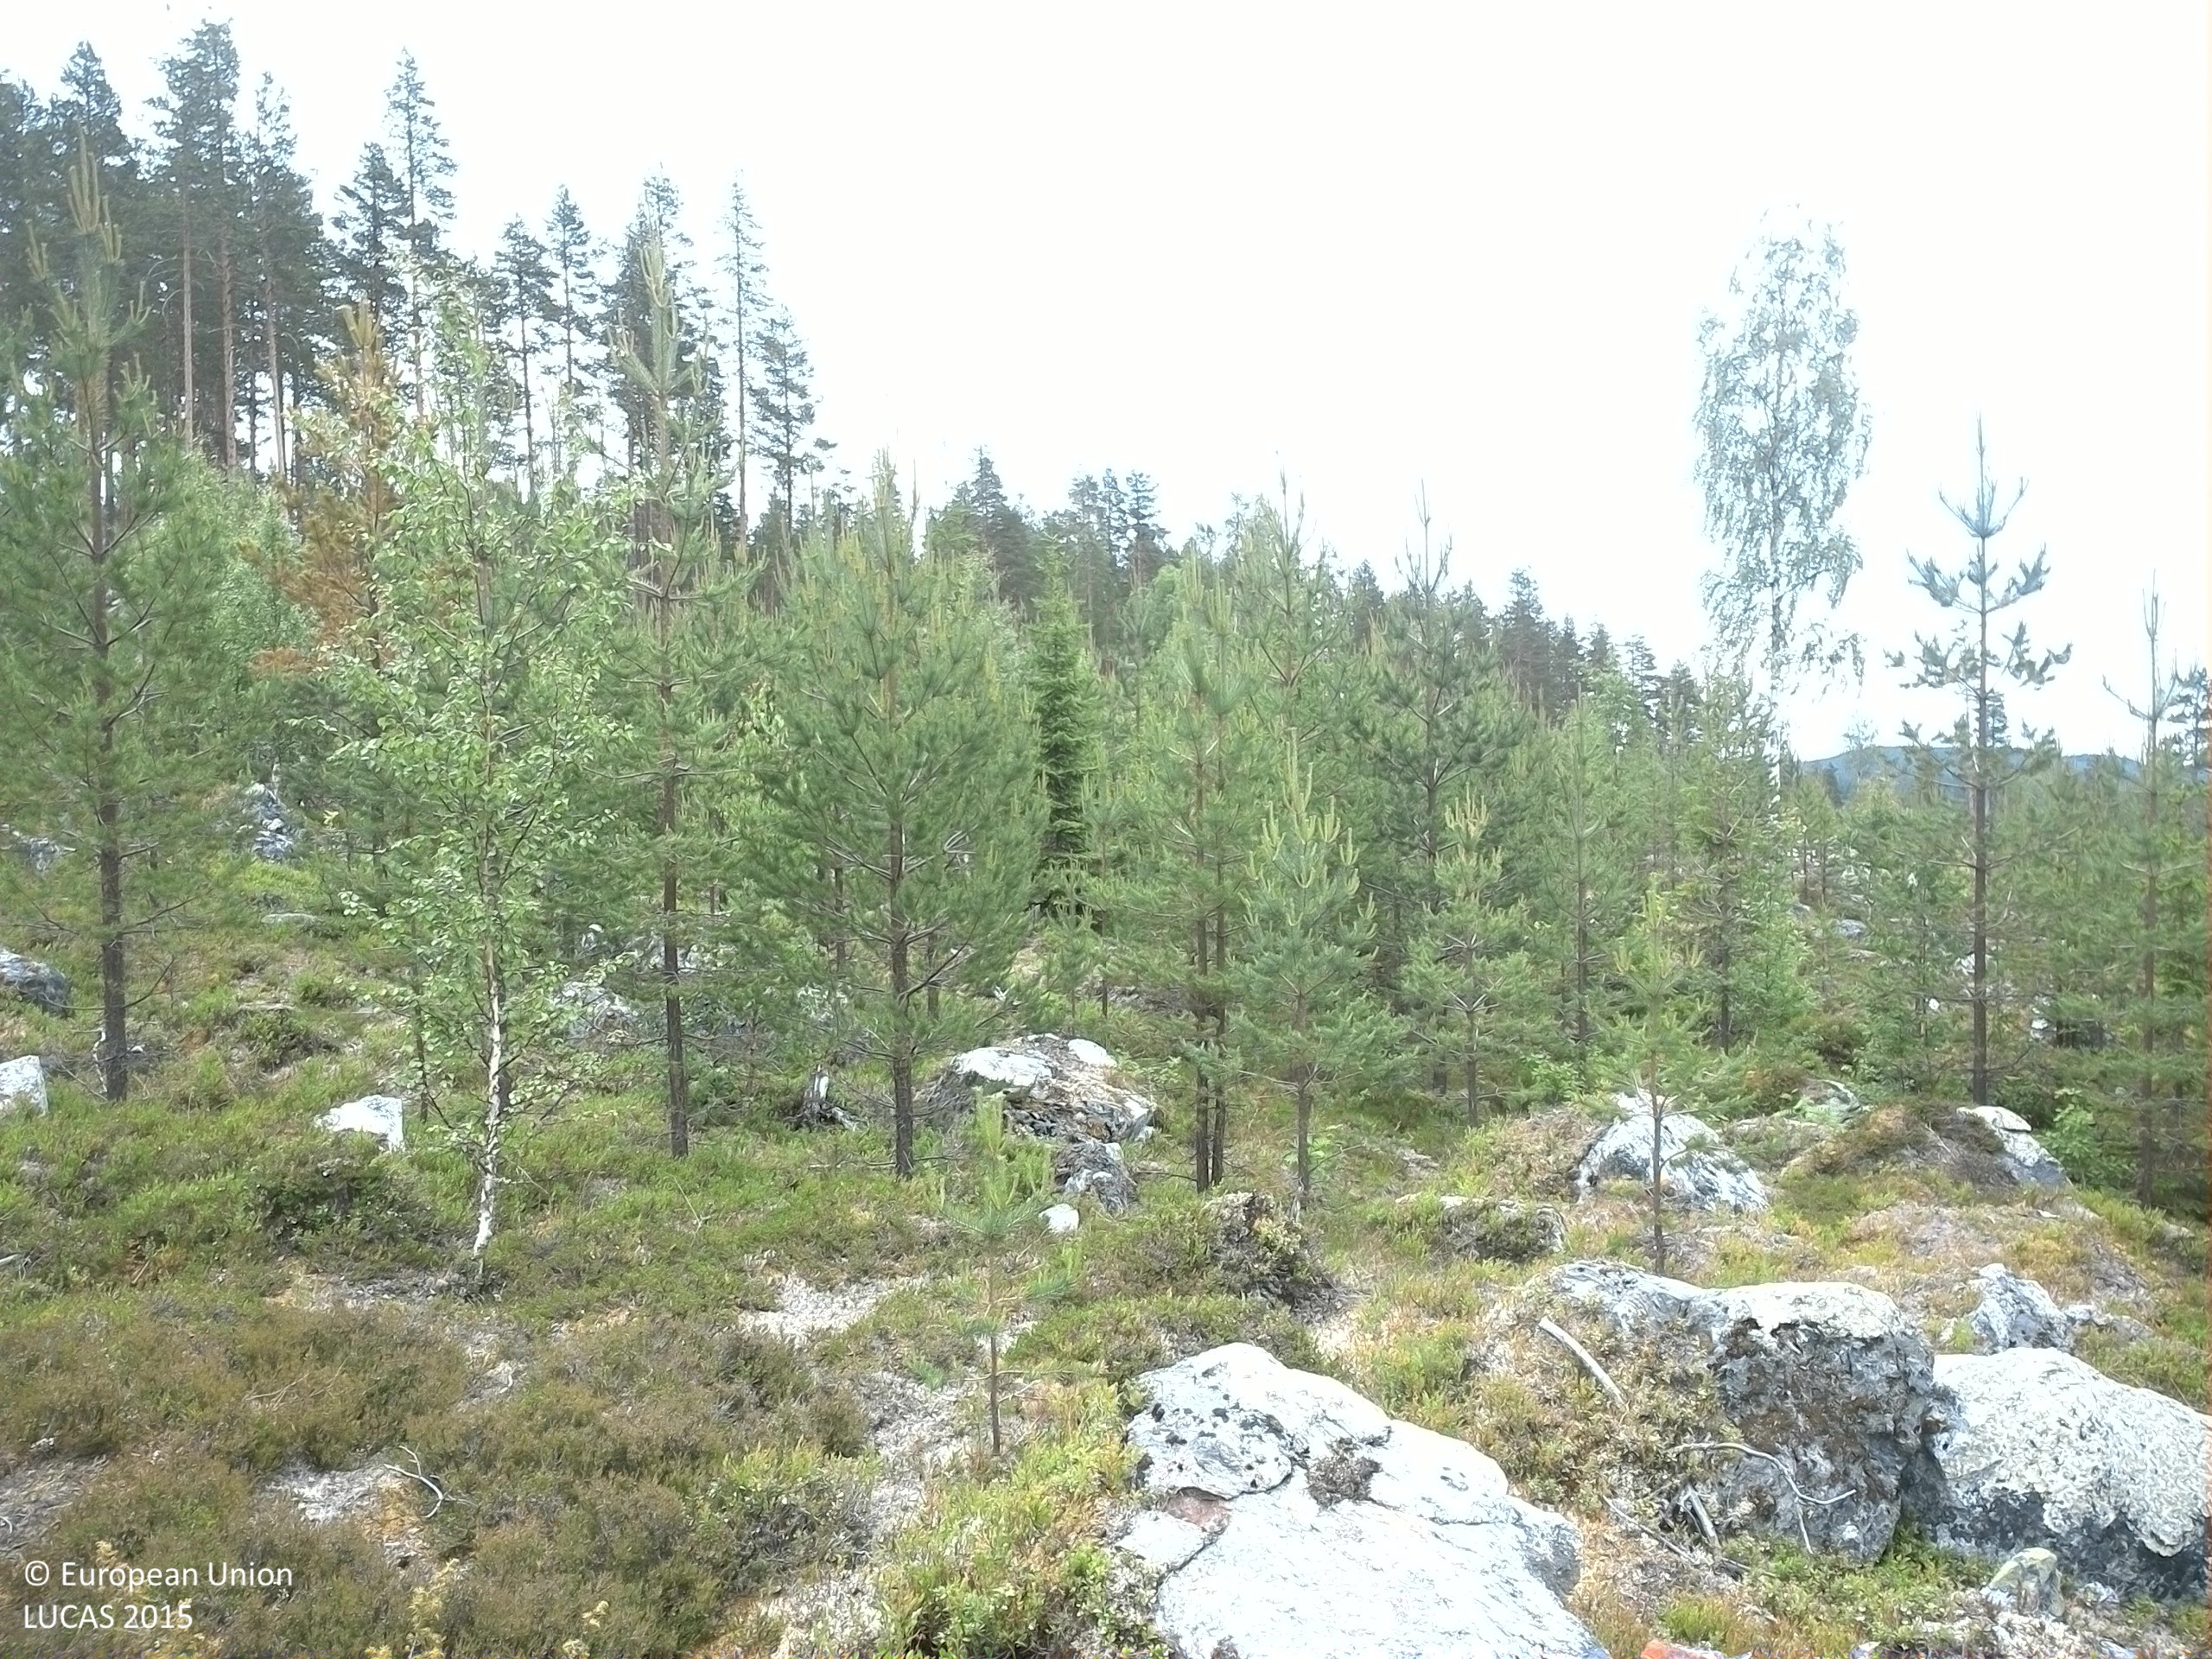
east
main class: Woodland
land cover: Pine dominated coniferous woodland
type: boreal forest
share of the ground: 50 - 75 %
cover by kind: coniferous forest trees 50 %, shrubs 20 %, lichens and mosses 20 %, broadleaved forest trees 10 %
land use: Forestry
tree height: < 5 m
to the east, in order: Pine dominated coniferous woodland
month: July
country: SE
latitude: 63.6063
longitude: 17.8170
